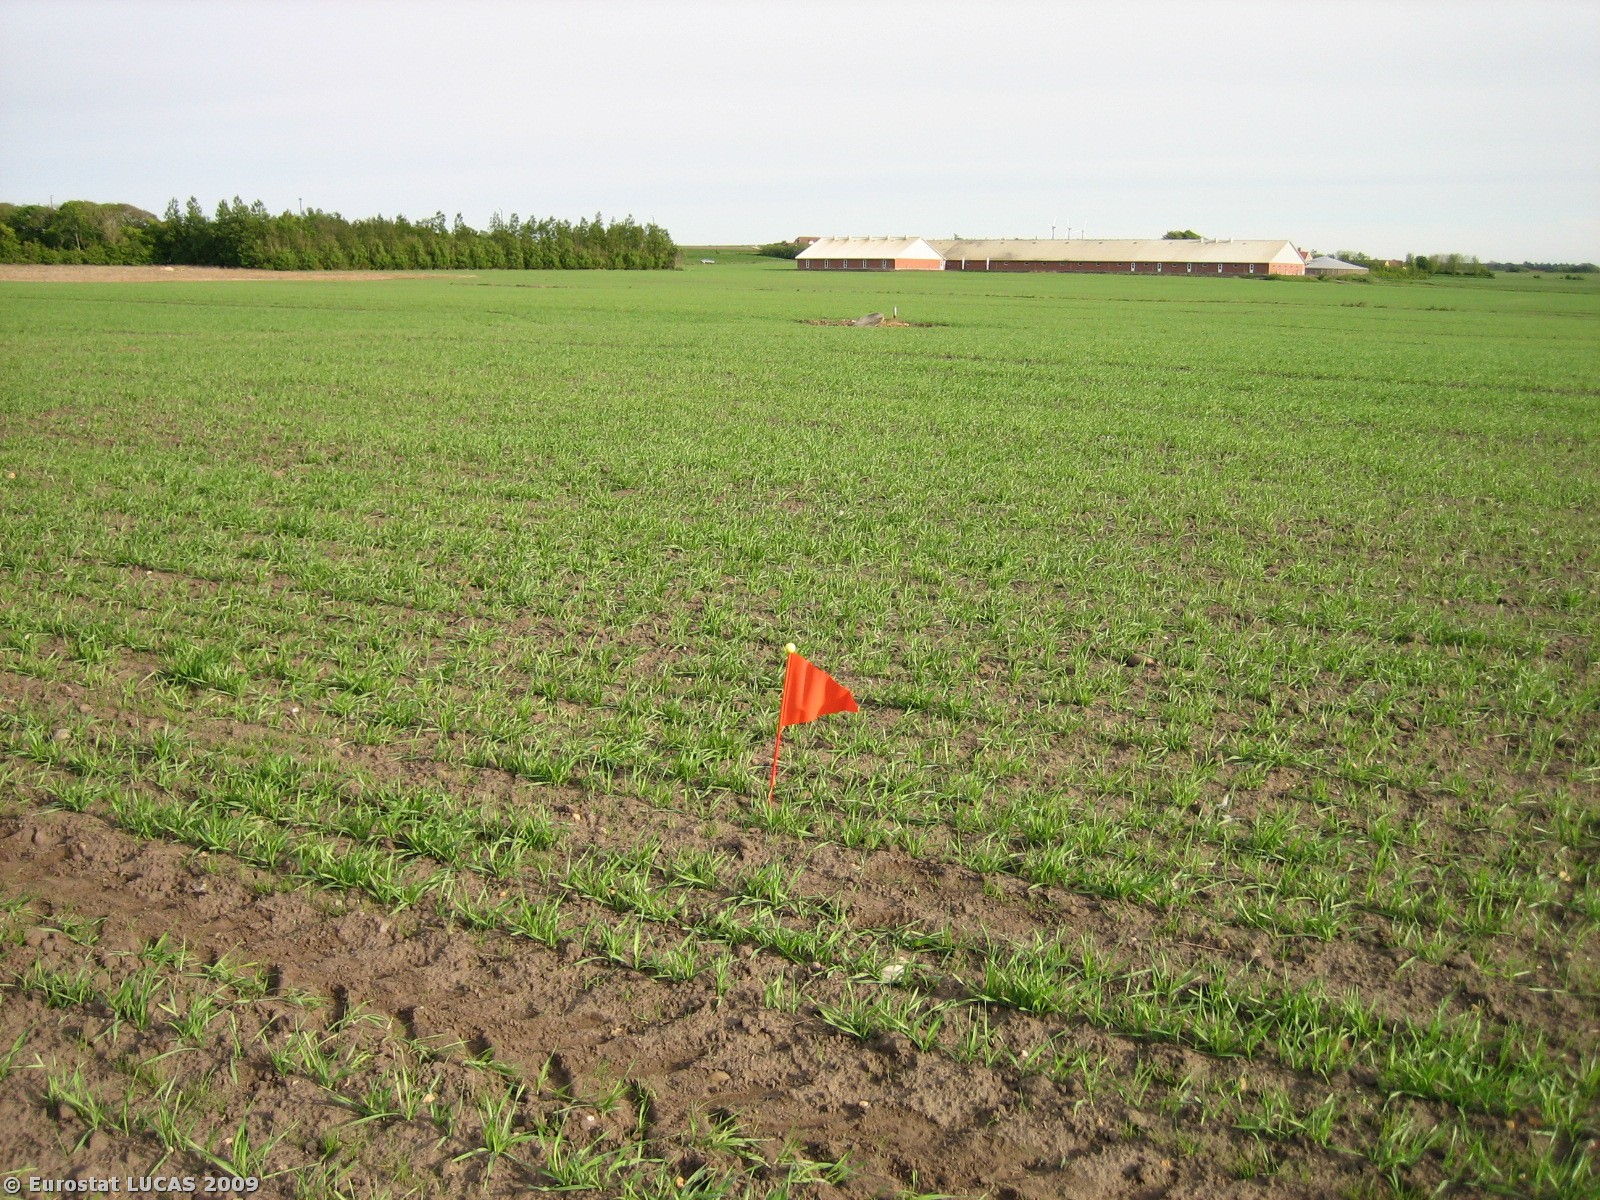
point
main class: Cropland
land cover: Barley
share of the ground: 25 - 50 %
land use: Agriculture (excluding fallow land and kitchen gardens)
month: May
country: DK
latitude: 56.1060
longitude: 8.4099
